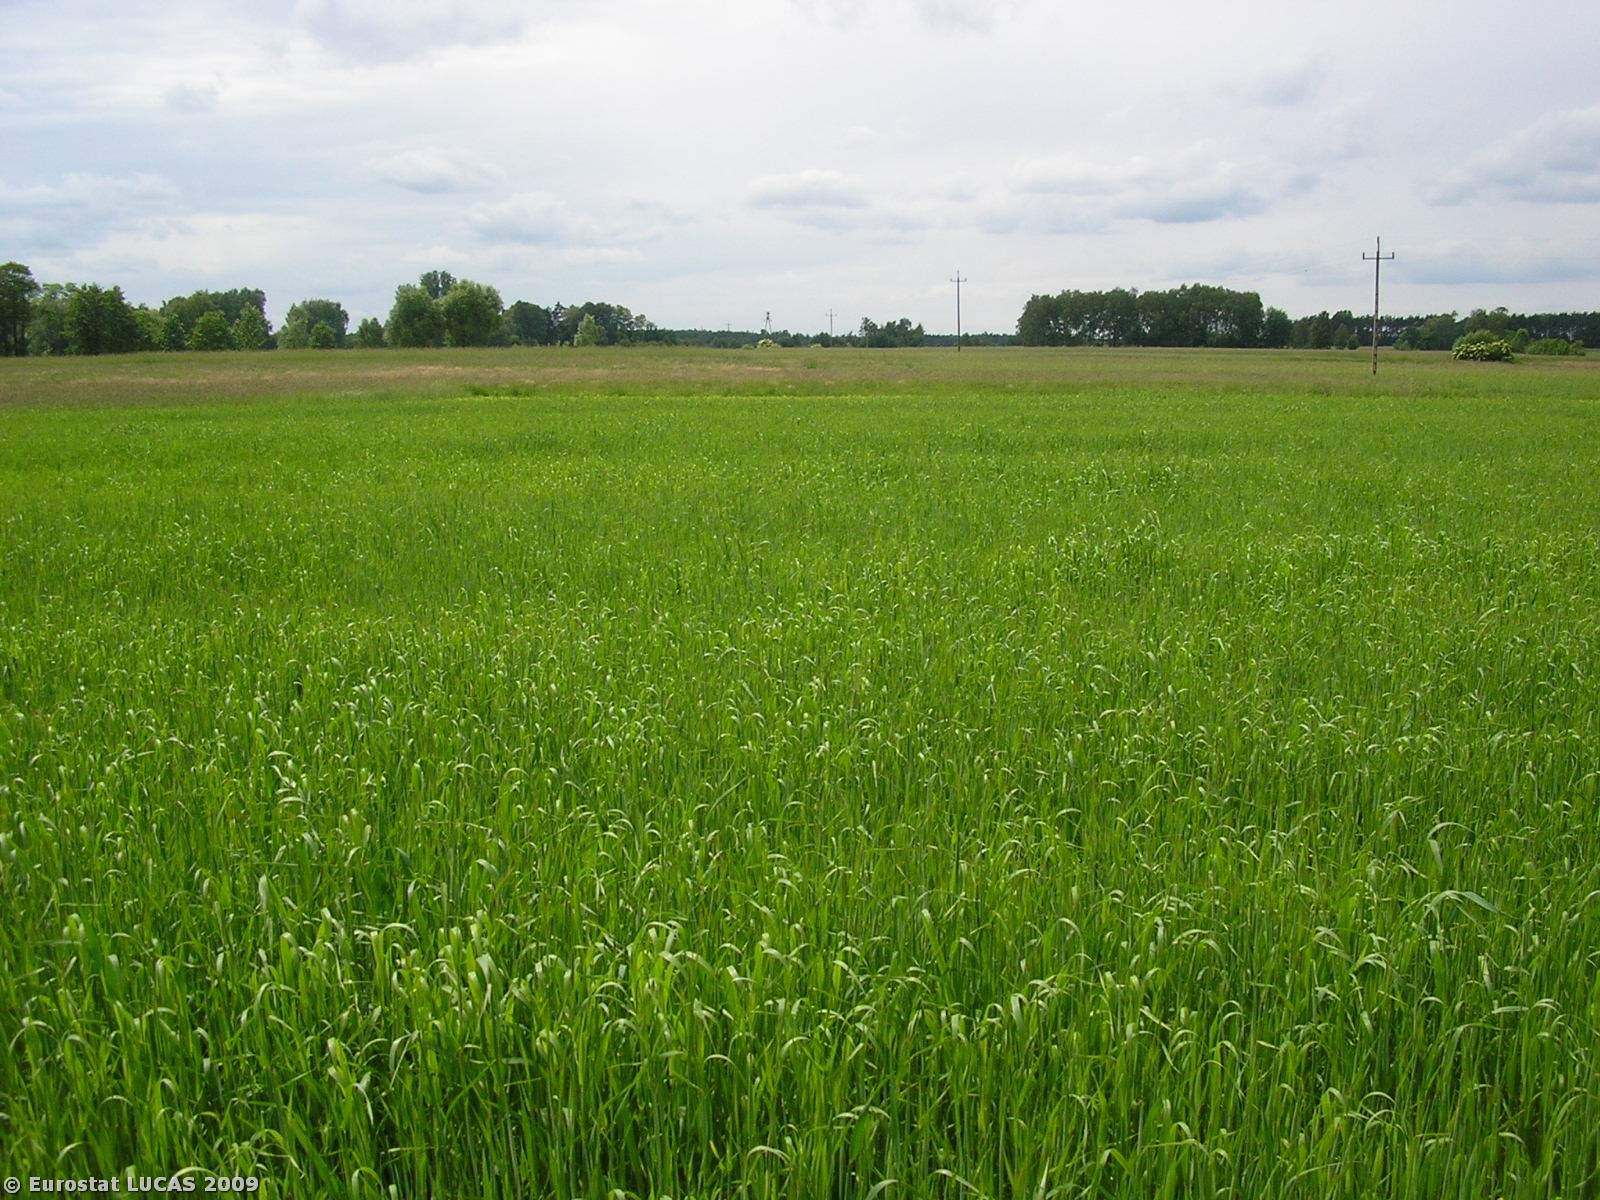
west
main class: Cropland
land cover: Barley
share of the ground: > 75 %
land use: Agriculture (excluding fallow land and kitchen gardens)
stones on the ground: 10 - 25 %
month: June
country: PL
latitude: 51.2988
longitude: 18.9293
